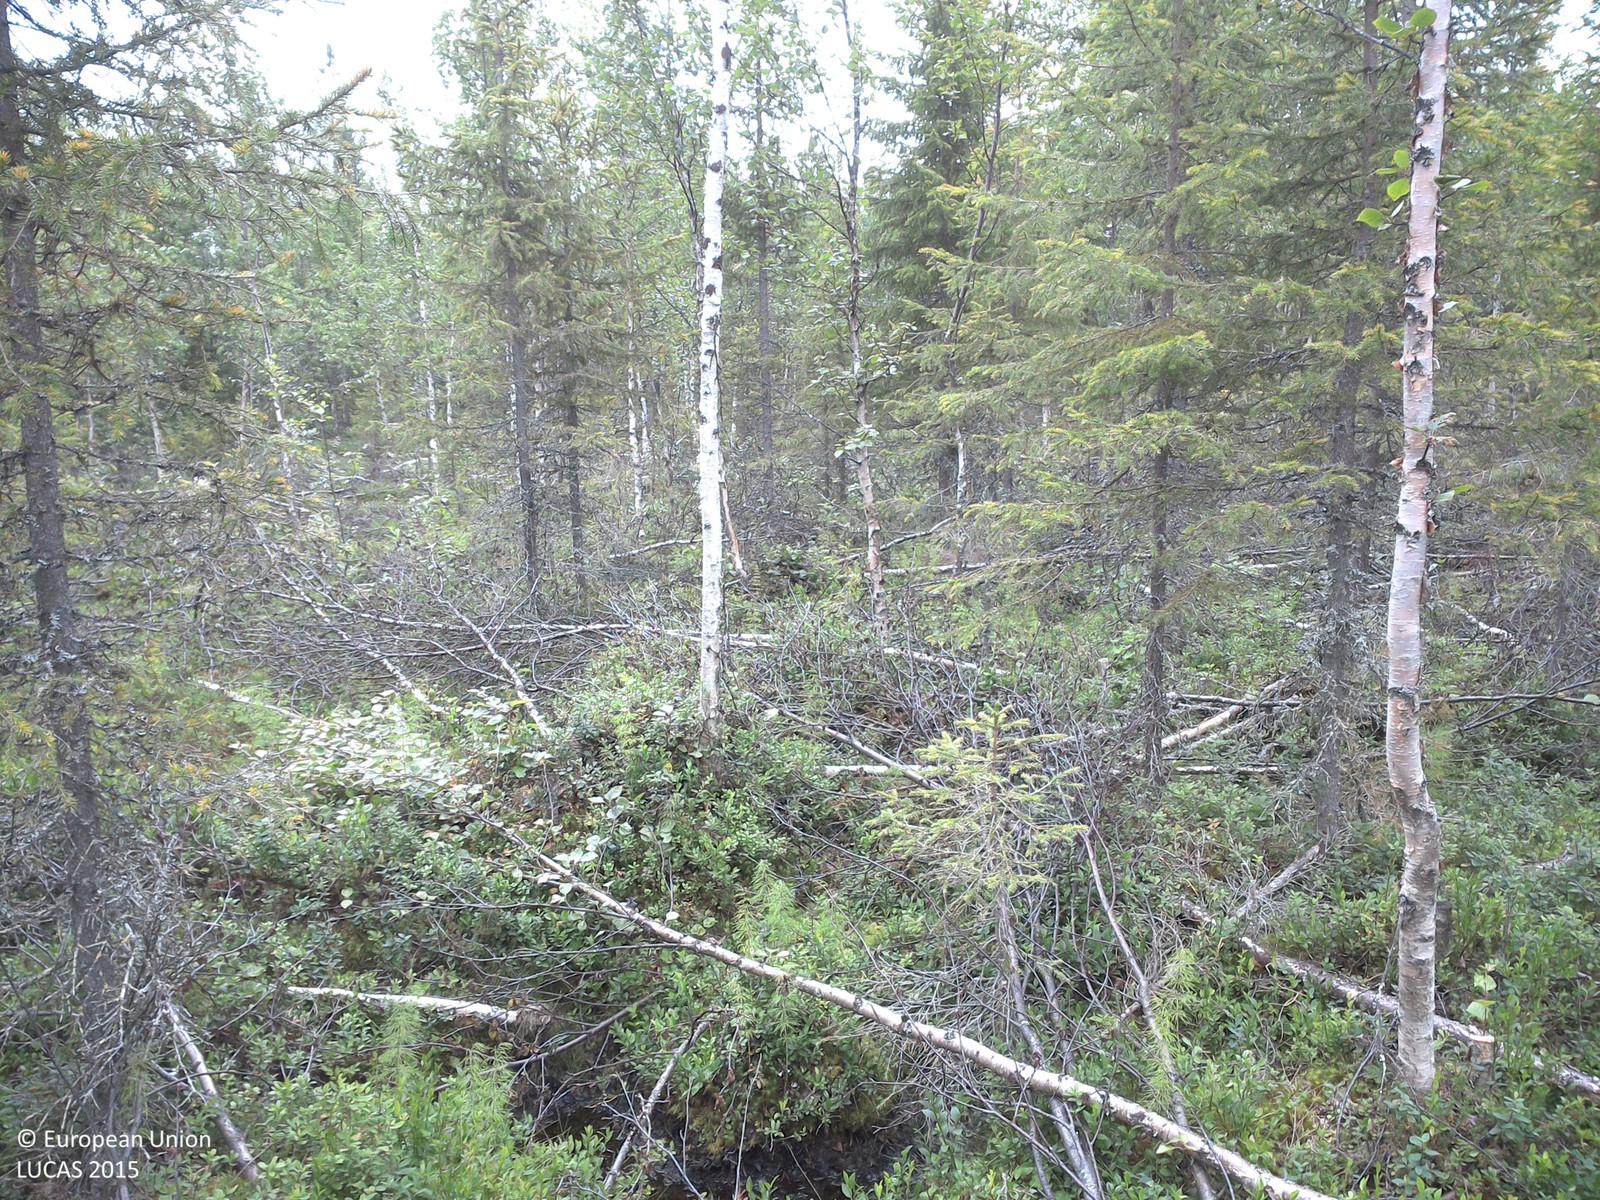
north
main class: Woodland
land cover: Pine dominated mixed woodland
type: boreal forest
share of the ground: 10 - 25 %
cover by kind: shrubs 80 %, coniferous forest trees 15 %, broadleaved forest trees 5 %
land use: Forestry
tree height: > 5 m
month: August
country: SE
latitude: 67.4487
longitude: 21.9403
